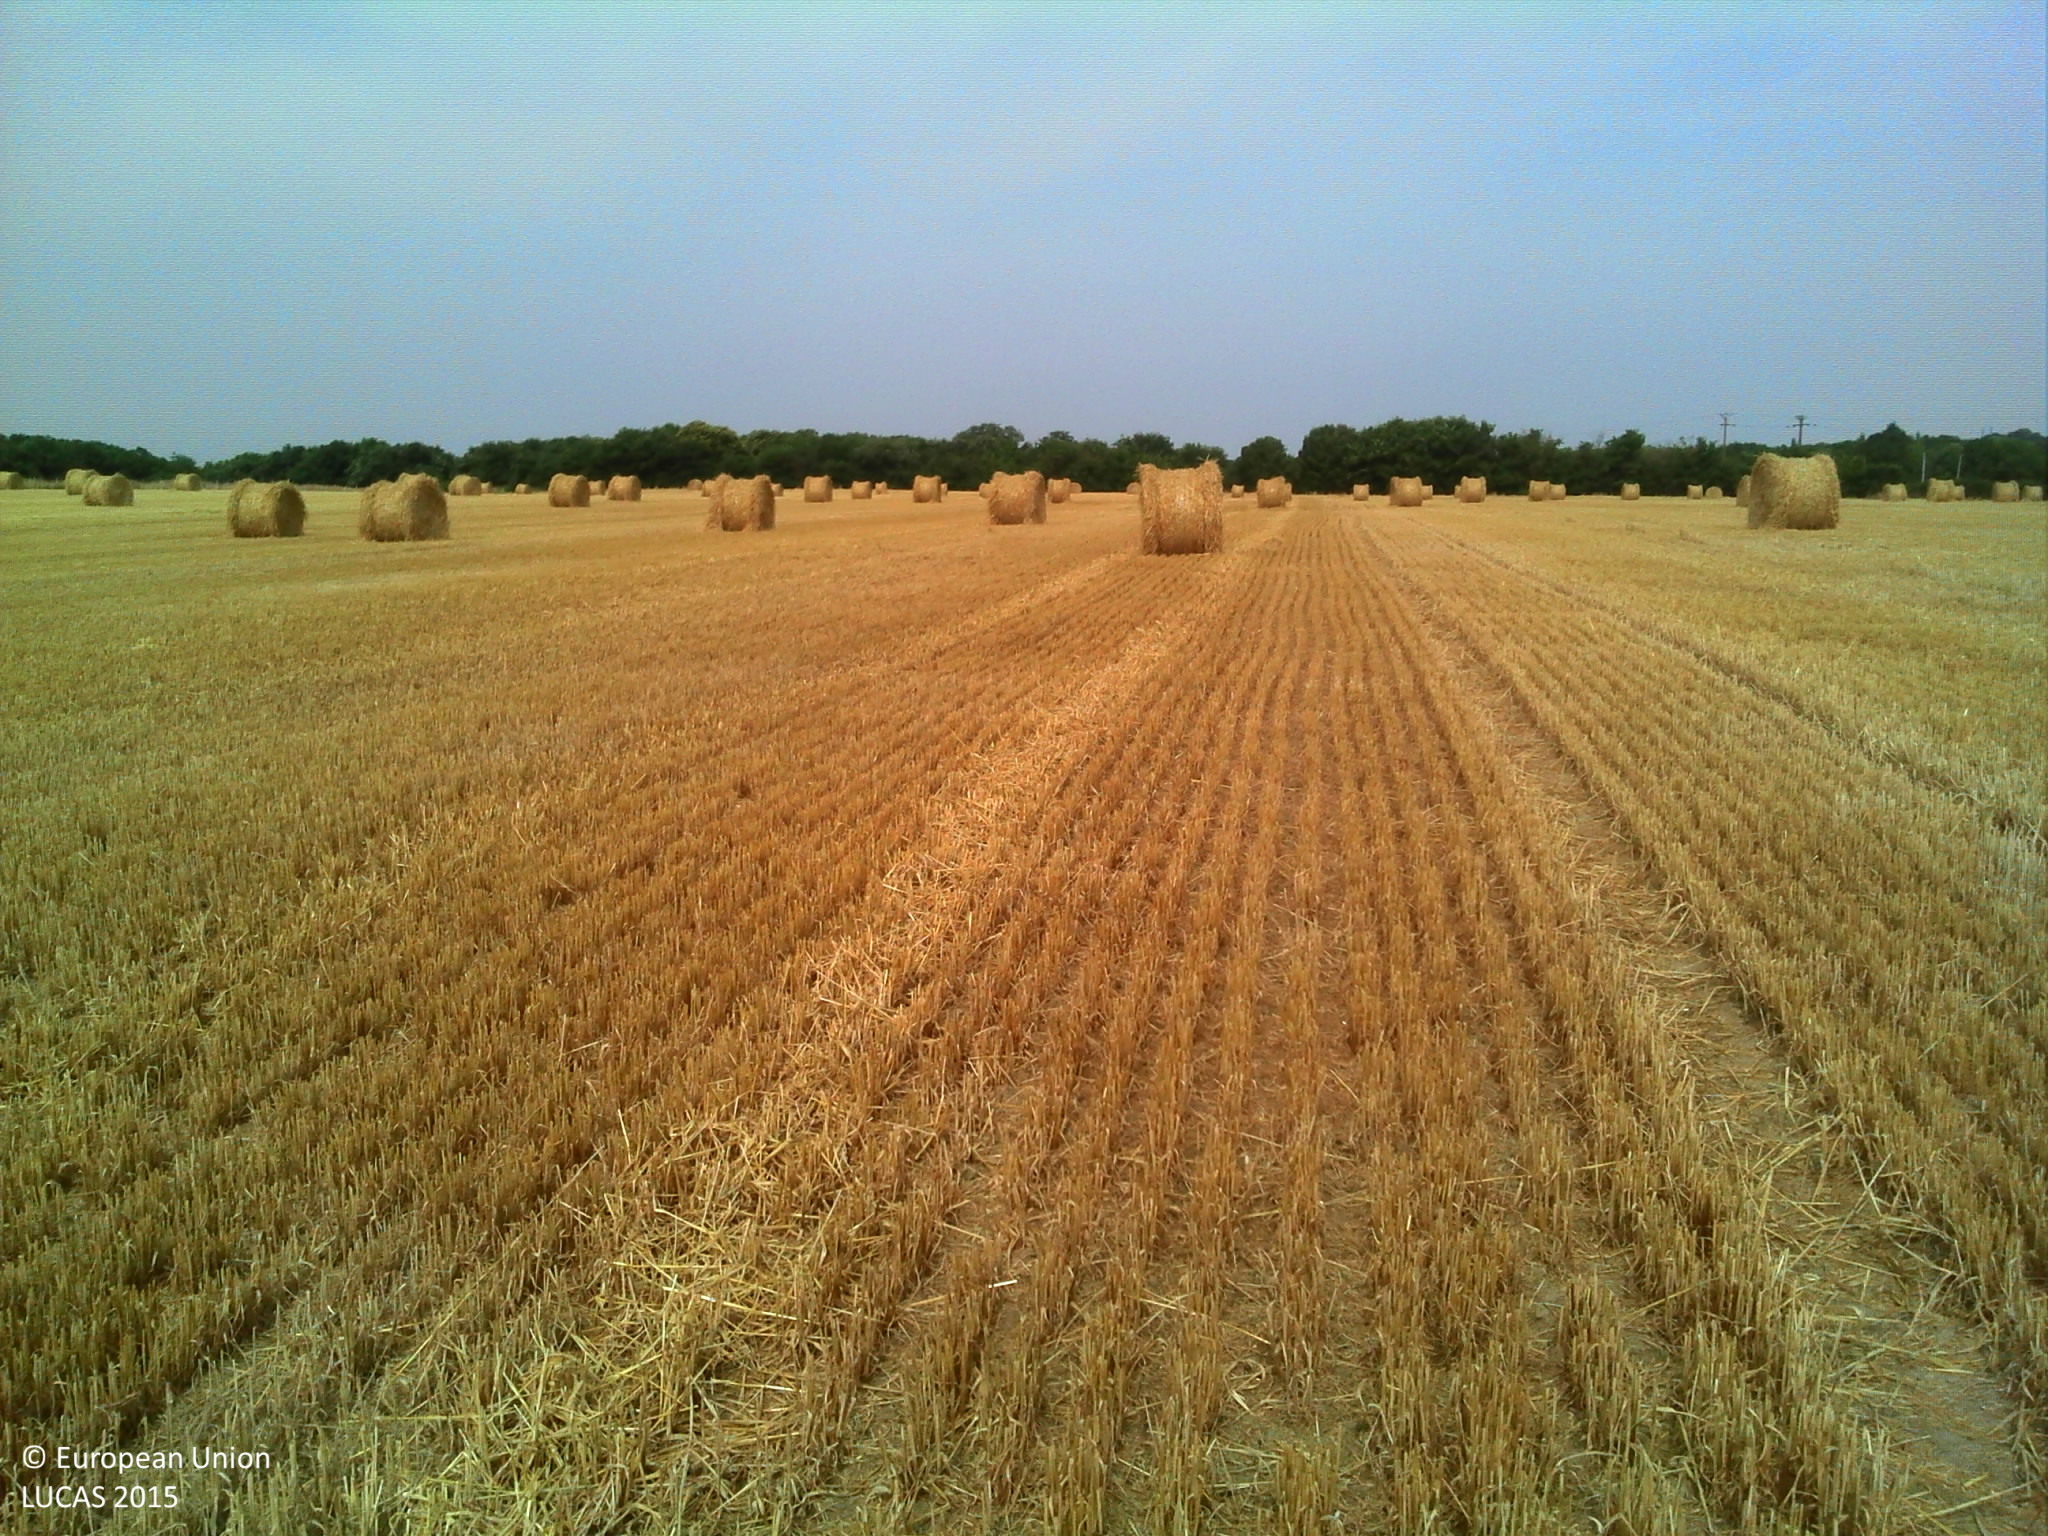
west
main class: Cropland
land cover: Barley
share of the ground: > 75 %
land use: Agriculture (excluding fallow land and kitchen gardens)
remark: Harvested field
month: July
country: FR
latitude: 47.2961
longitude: -1.8022
